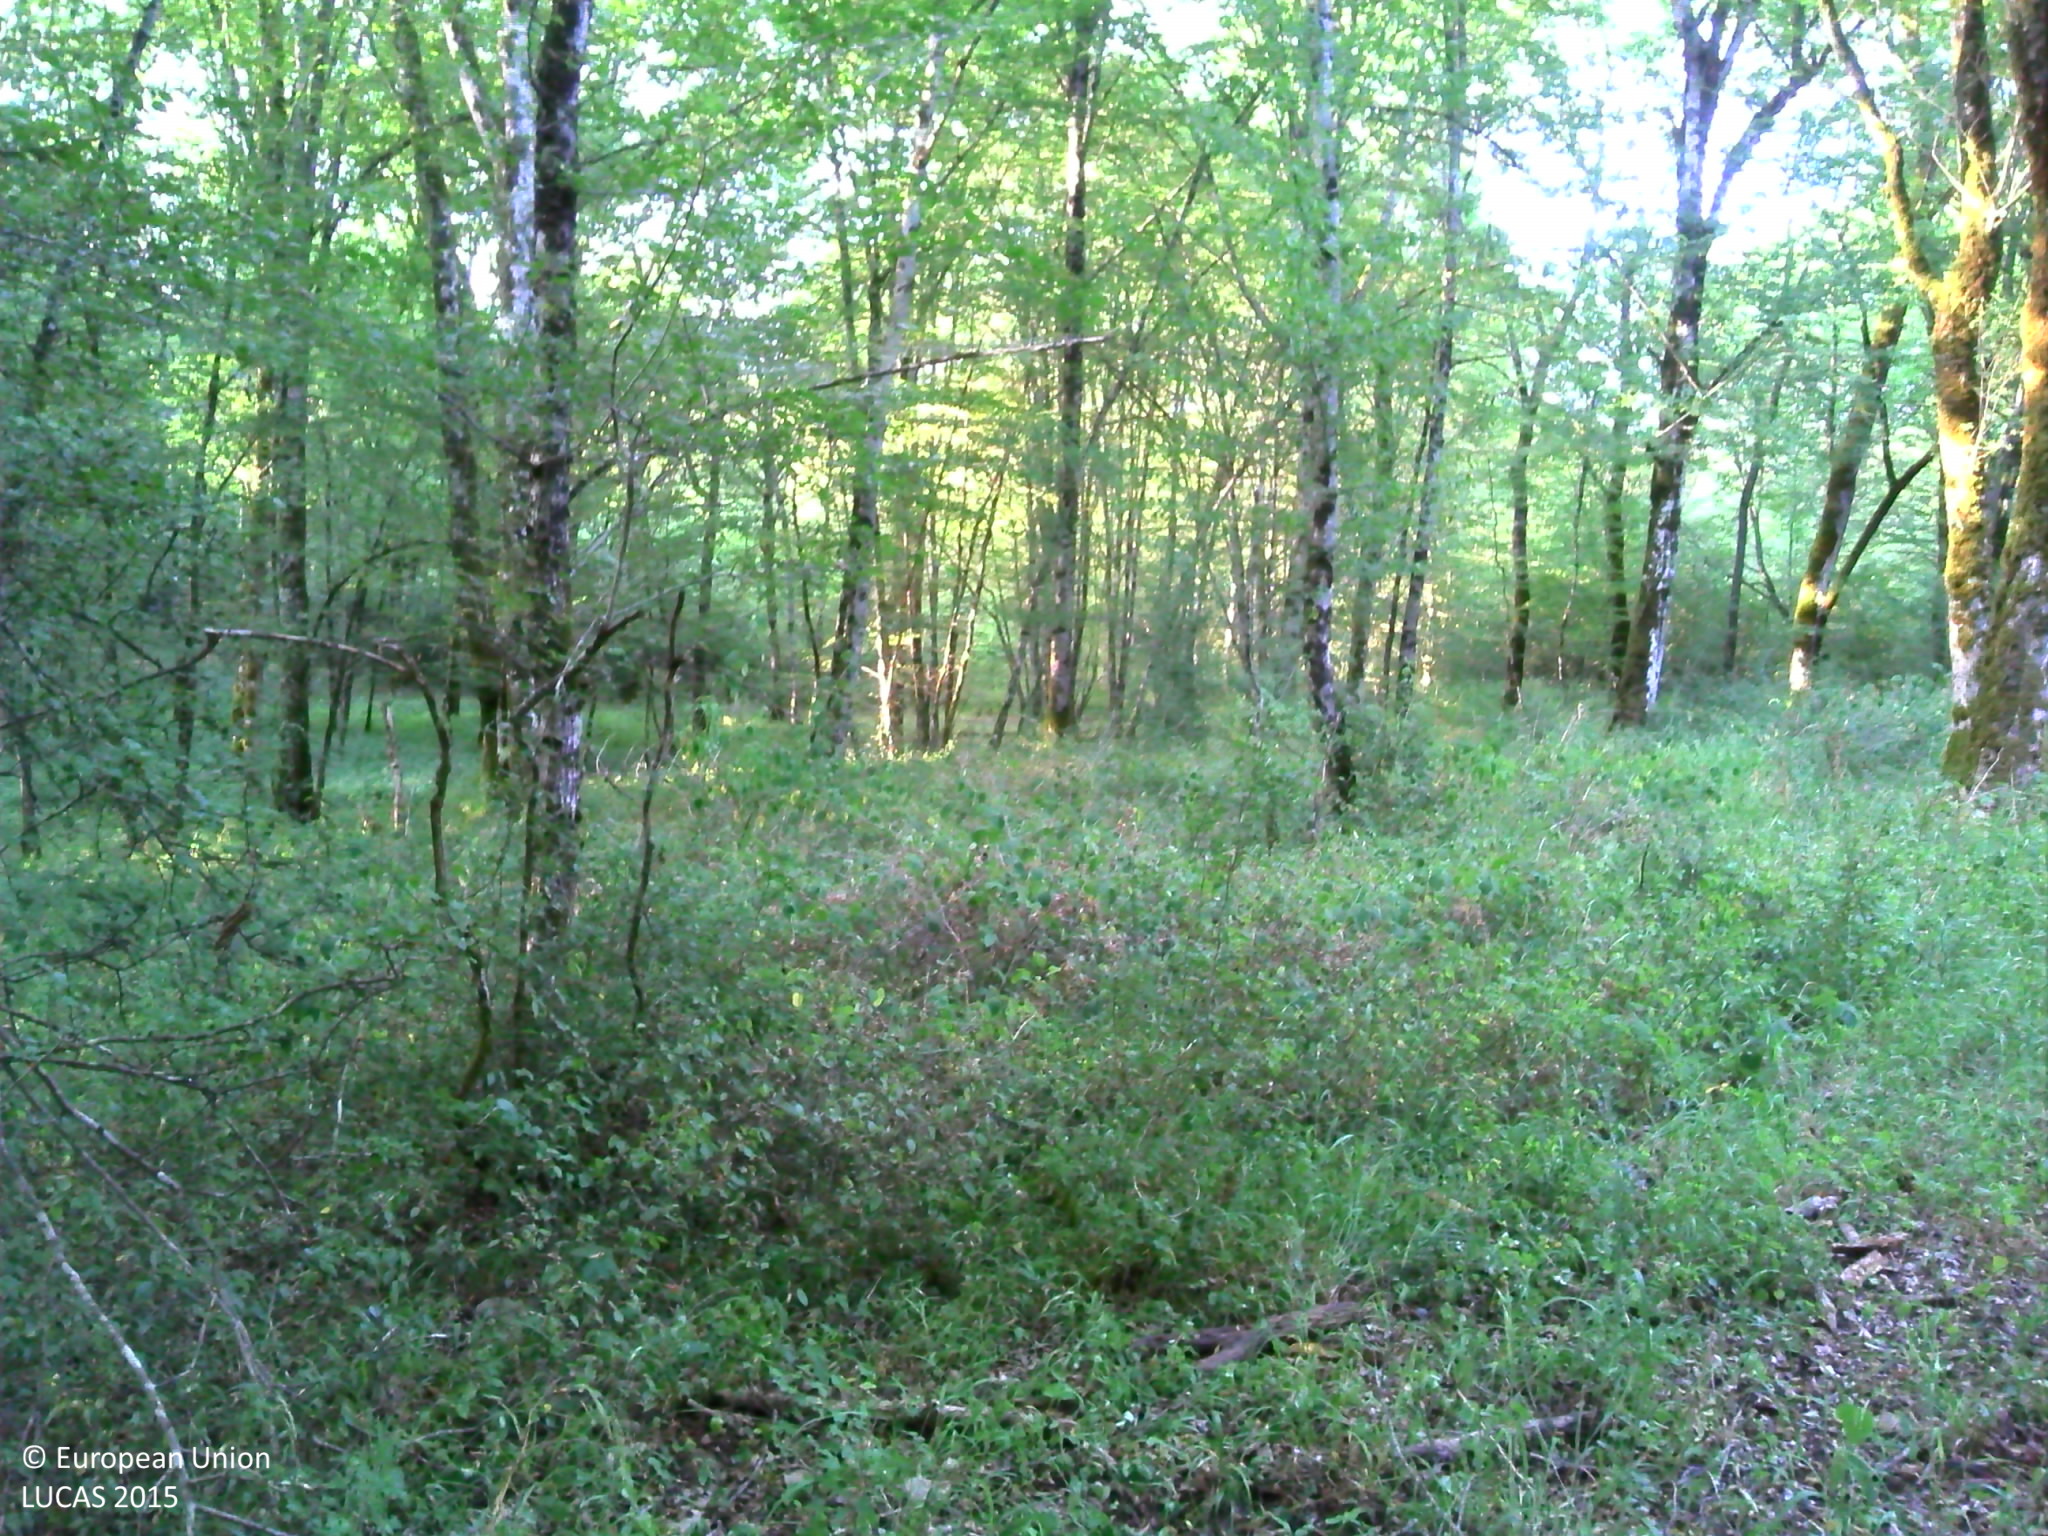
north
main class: Woodland
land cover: Broadleaved woodland
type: mesophytic deciduous forest
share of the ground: > 75 %
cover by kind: broadleaved forest trees 75 %, shrubs 10 %, lichens and mosses 10 %, herbaceous plants 5 %
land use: Forestry
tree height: > 5 m
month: July
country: FR
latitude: 48.0199
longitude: 4.9980
